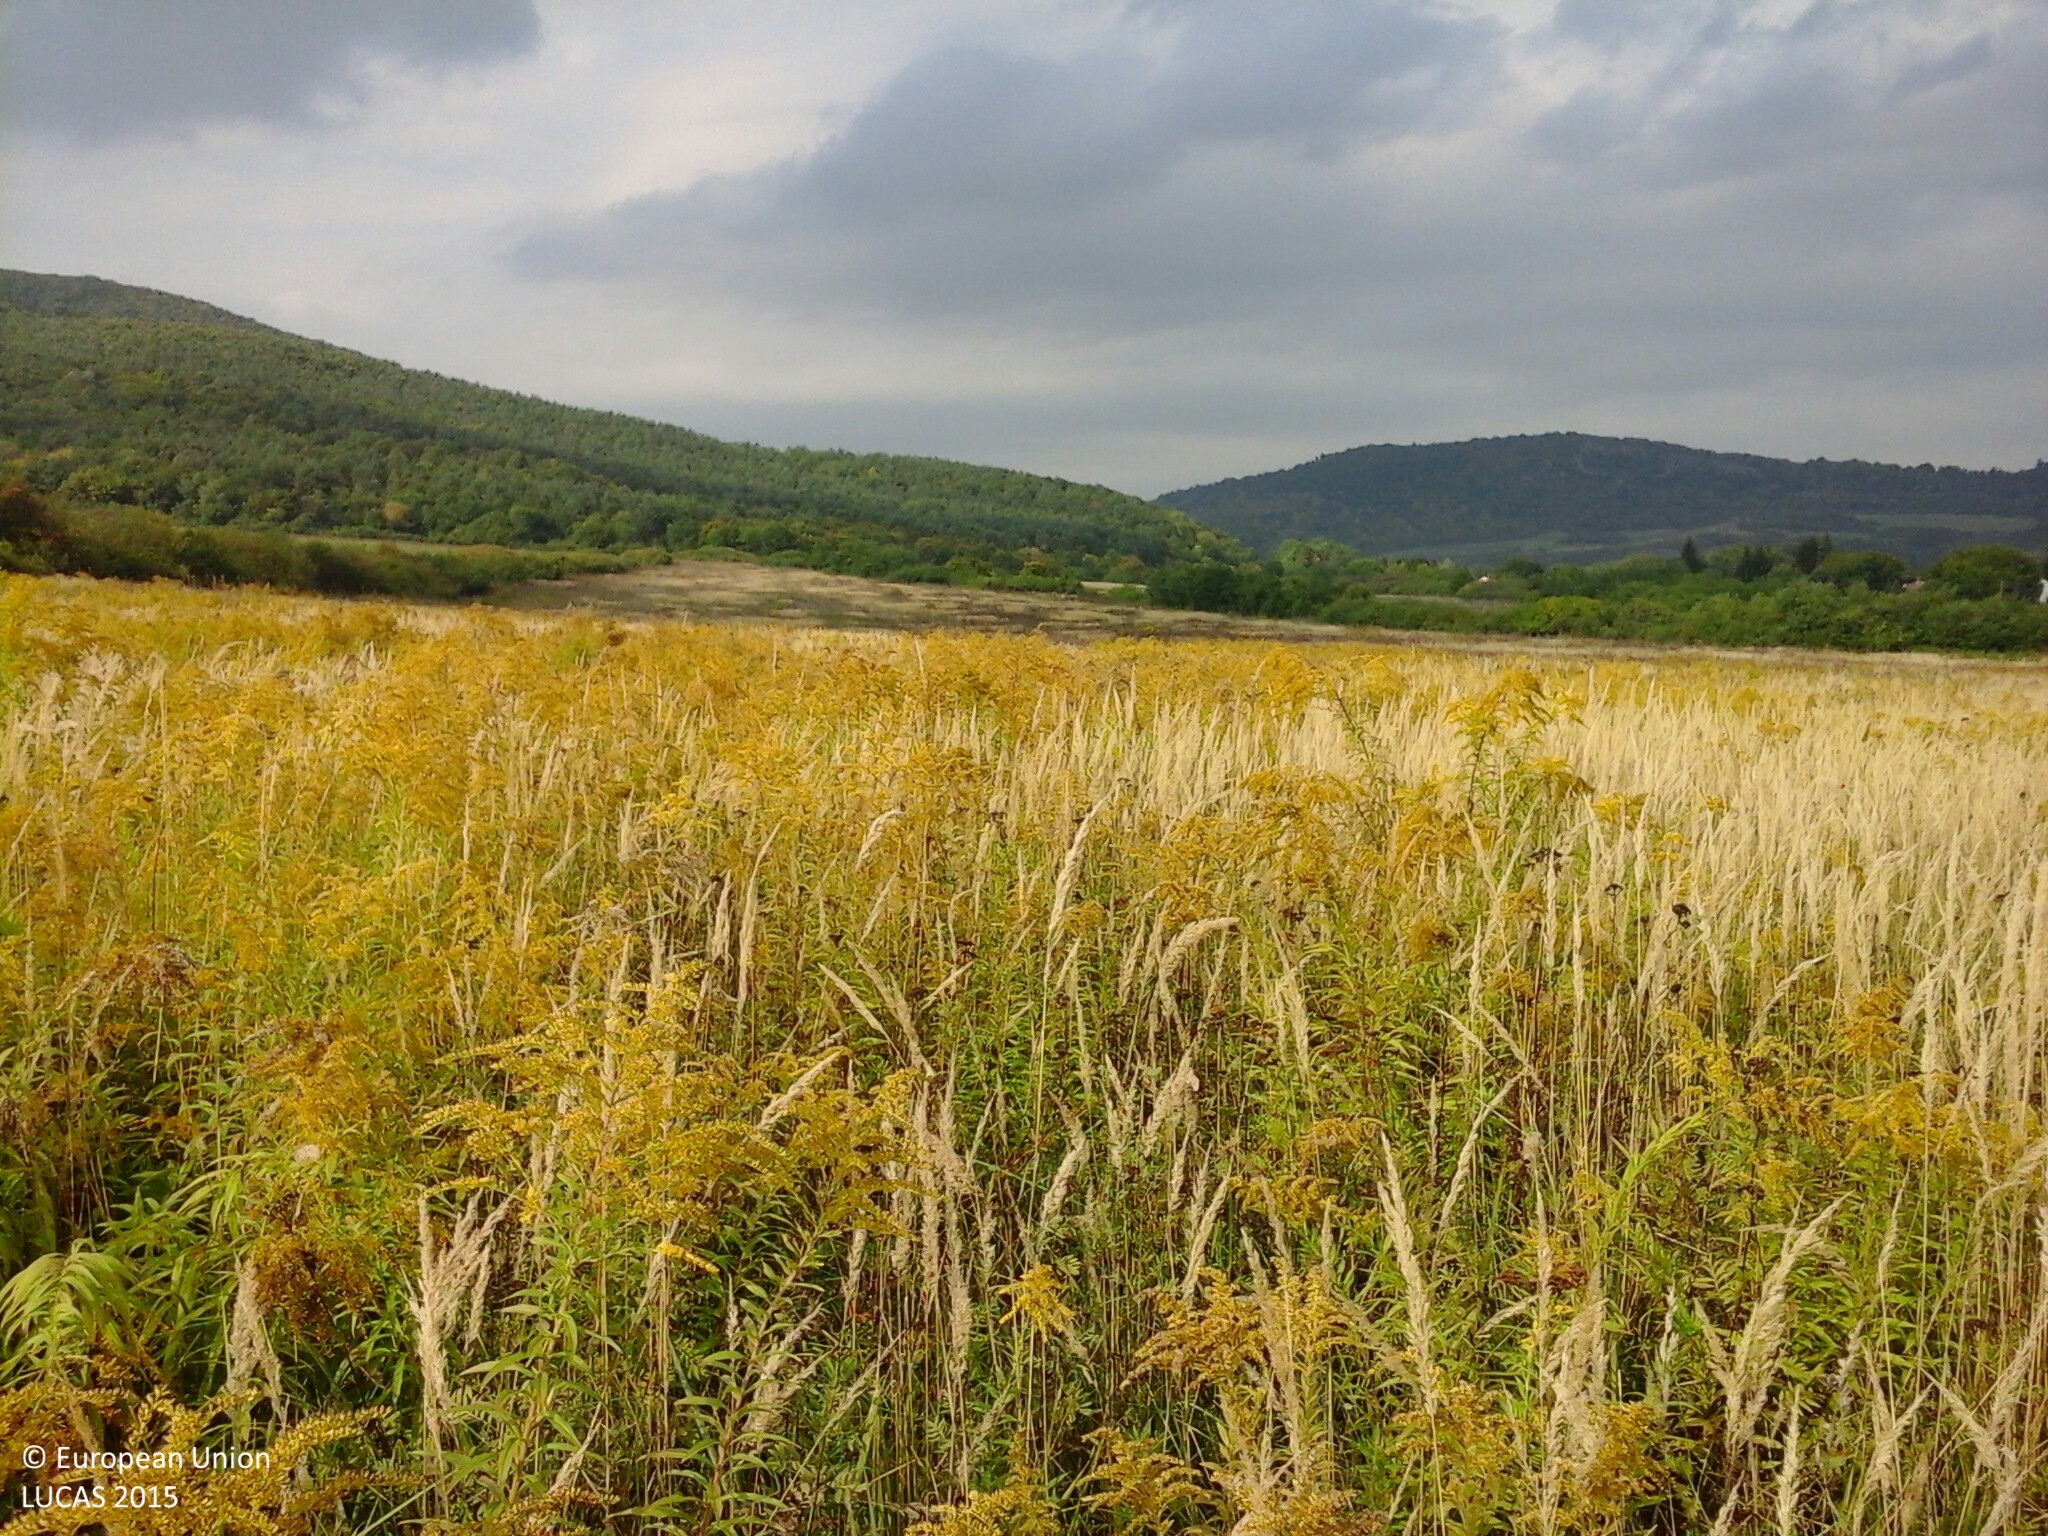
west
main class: Grassland
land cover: Spontaneously vegetated surfaces
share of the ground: > 75 %
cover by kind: herbaceous plants 100 %
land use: Abandoned areas
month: September
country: HU
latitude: 47.9680
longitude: 19.7903
